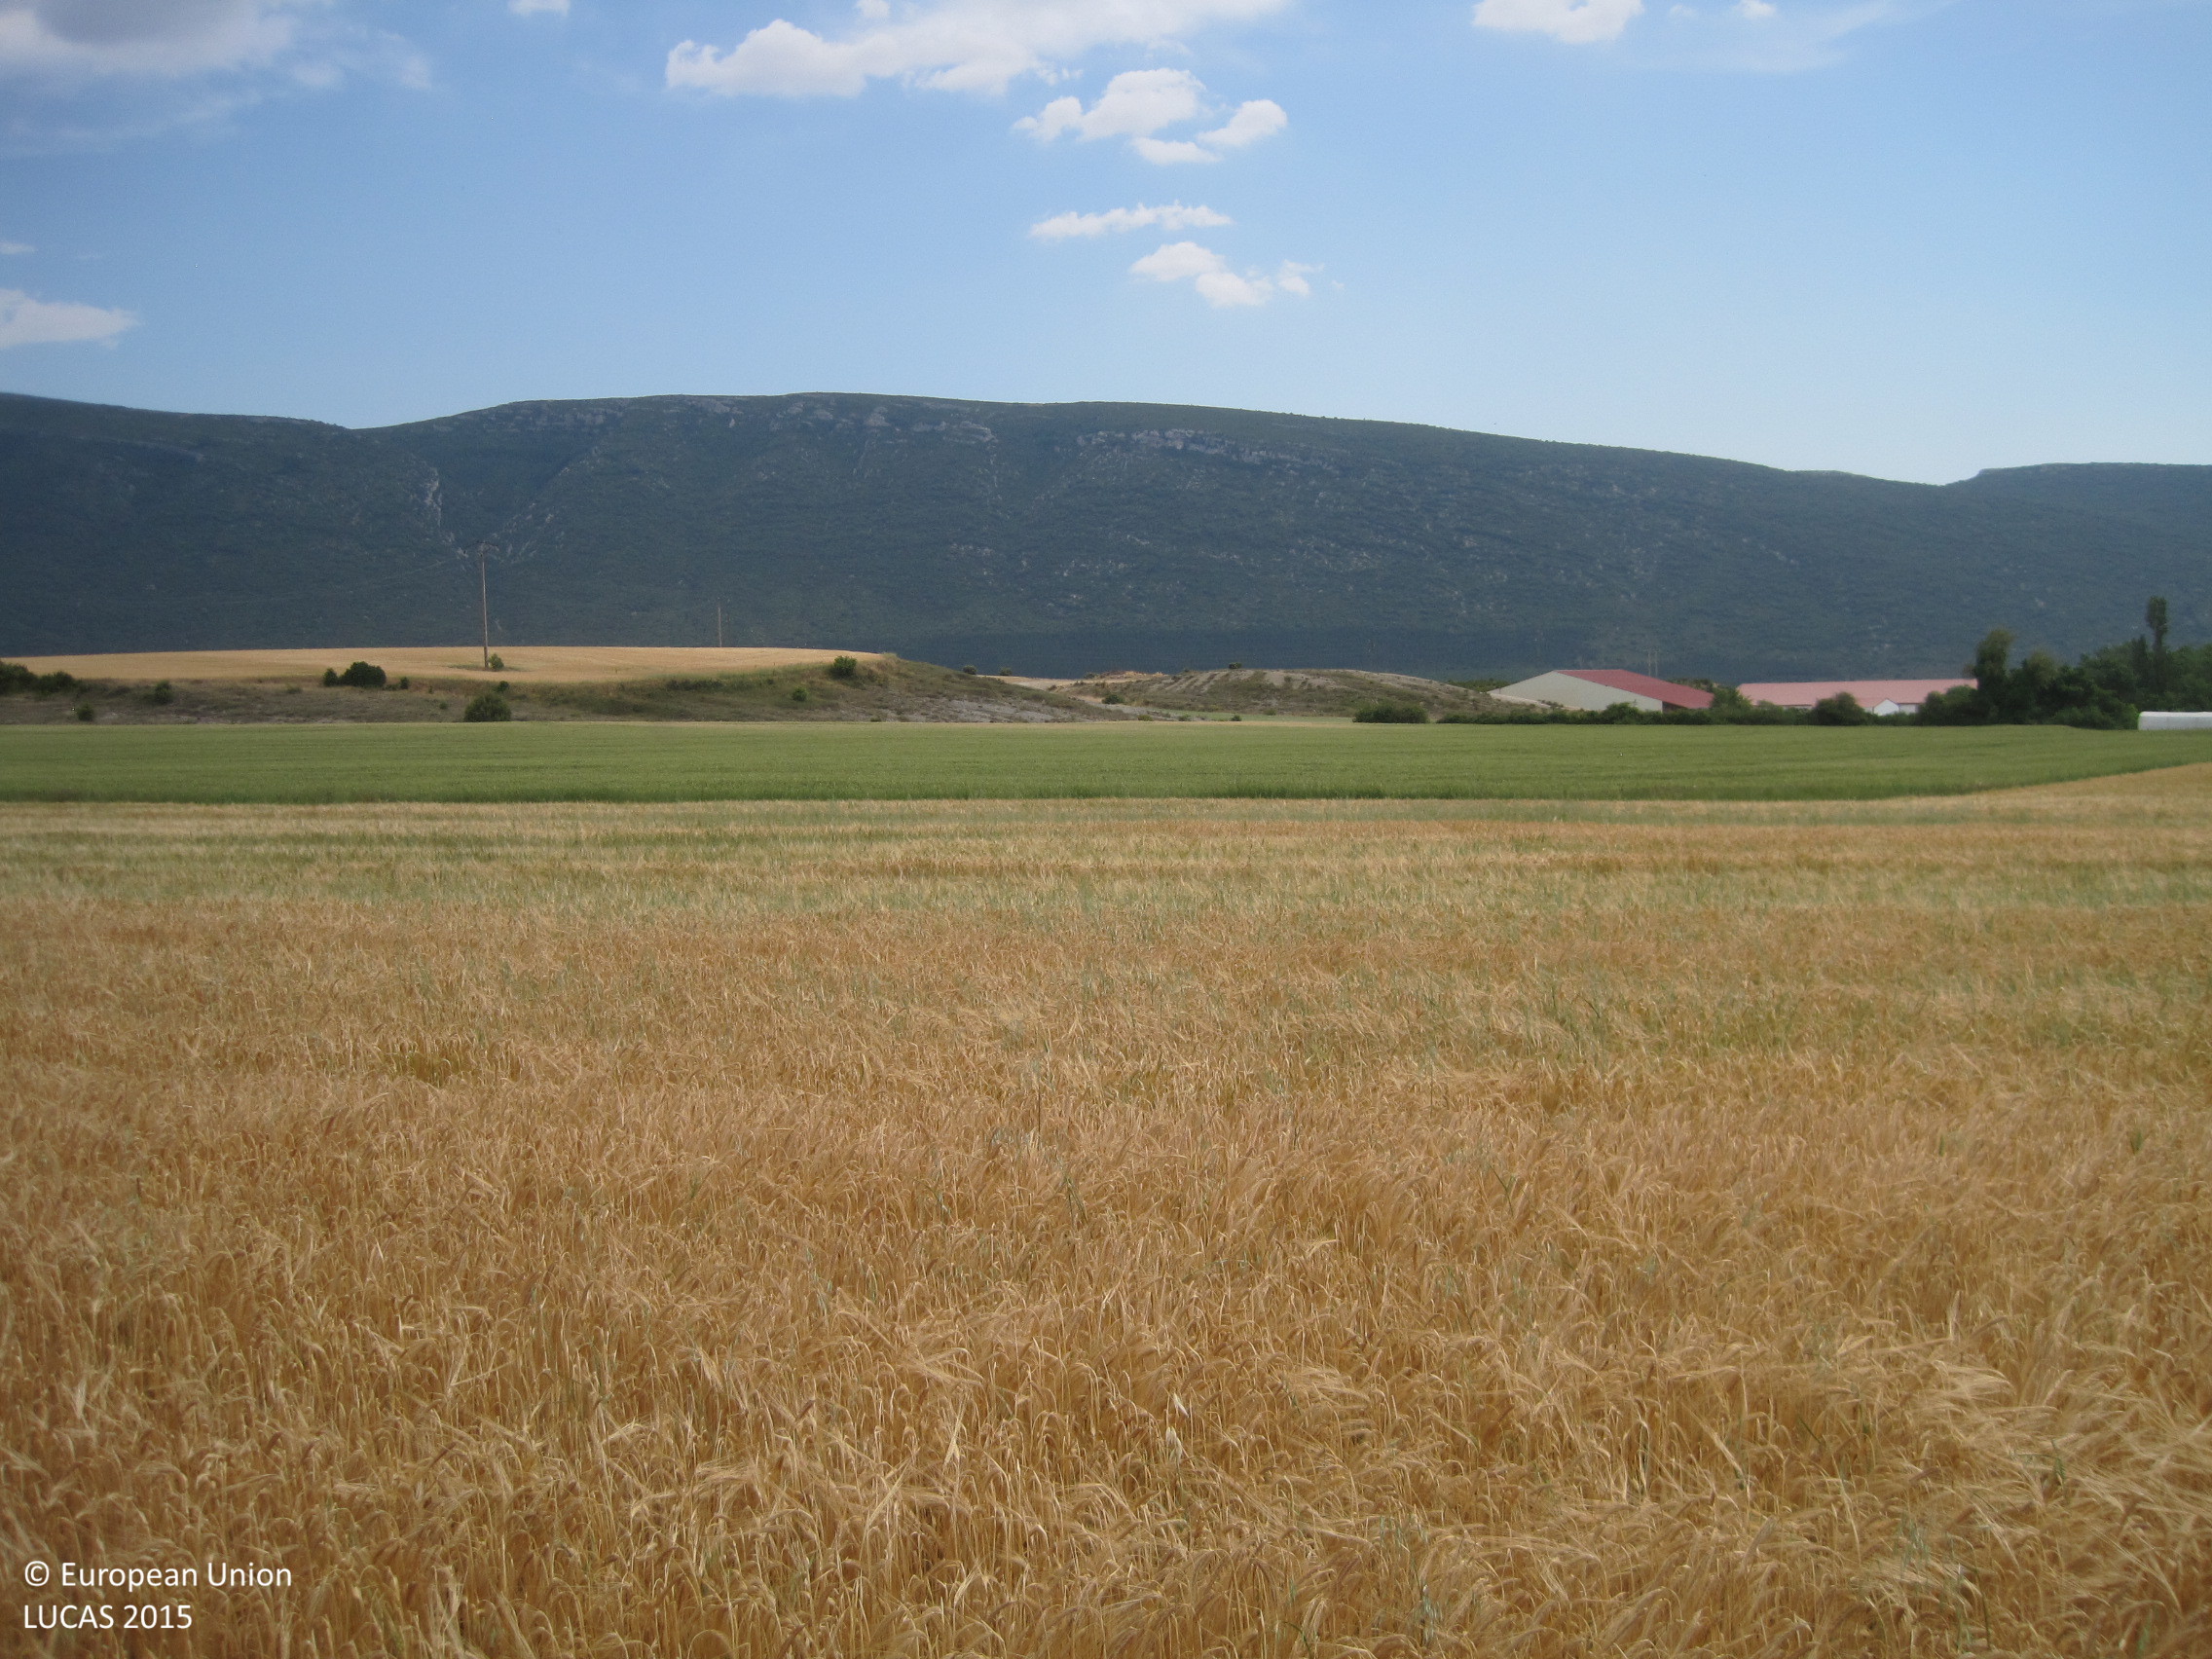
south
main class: Cropland
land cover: Barley
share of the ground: > 75 %
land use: Agriculture (excluding fallow land and kitchen gardens)
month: June
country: ES
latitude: 42.6810
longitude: -1.2493
